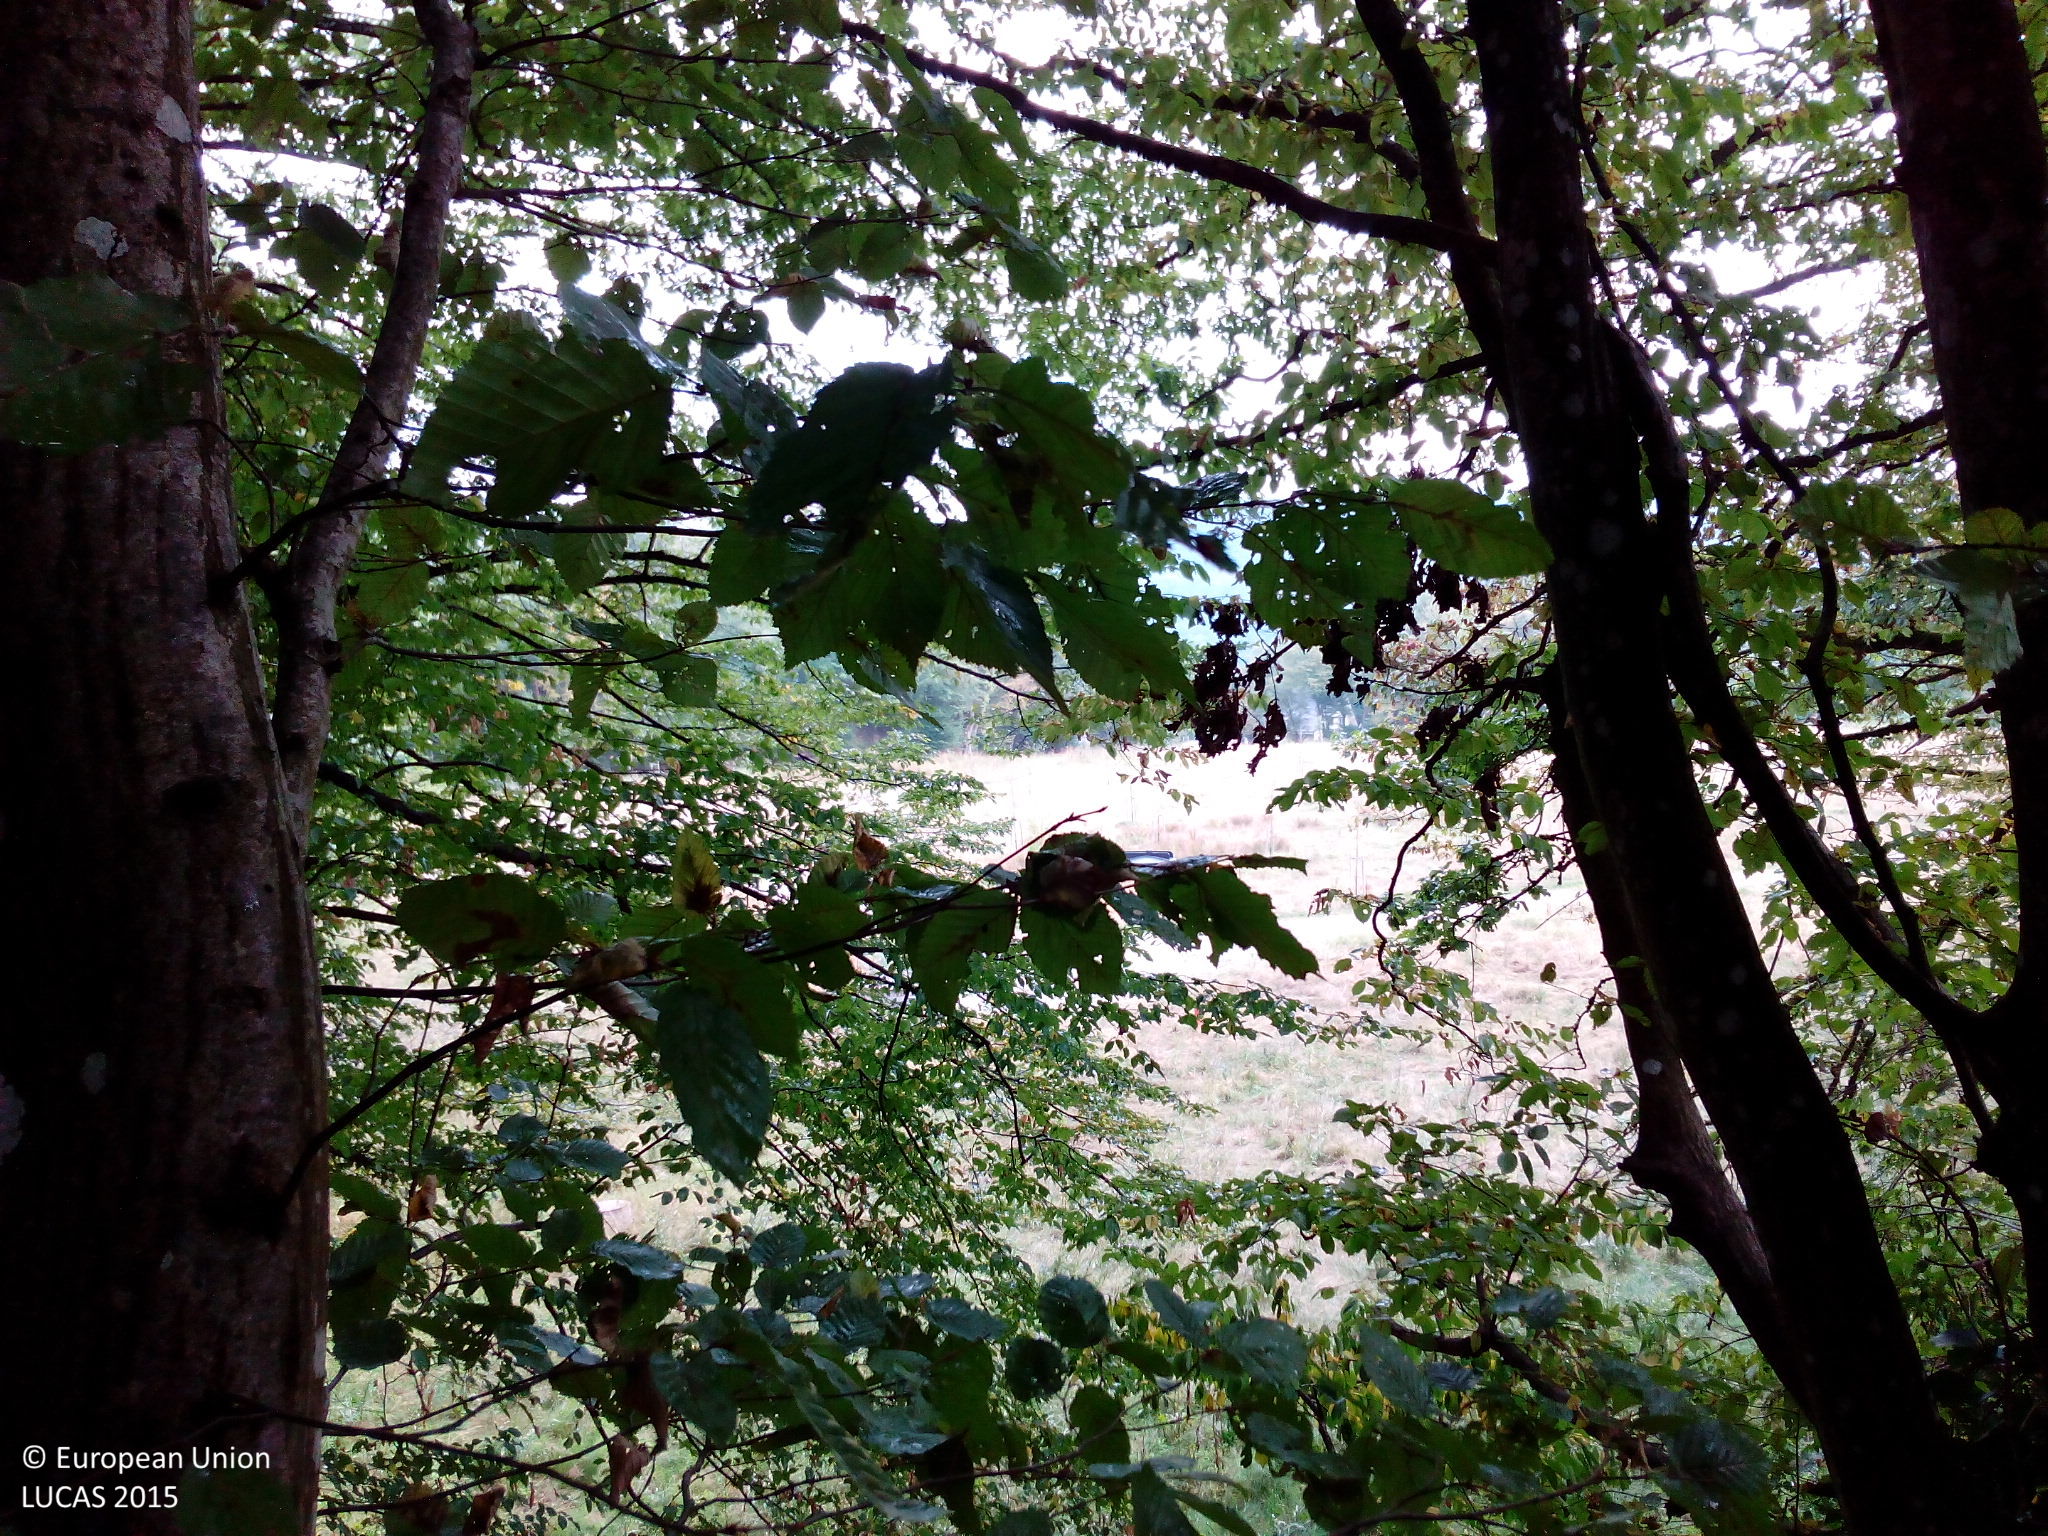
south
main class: Woodland
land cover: Broadleaved woodland
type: beech forest
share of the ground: > 75 %
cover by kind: broadleaved forest trees 80 %, herbaceous plants 20 %
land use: Abandoned areas
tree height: > 5 m
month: August
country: DE
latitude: 47.5956
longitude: 8.1262
